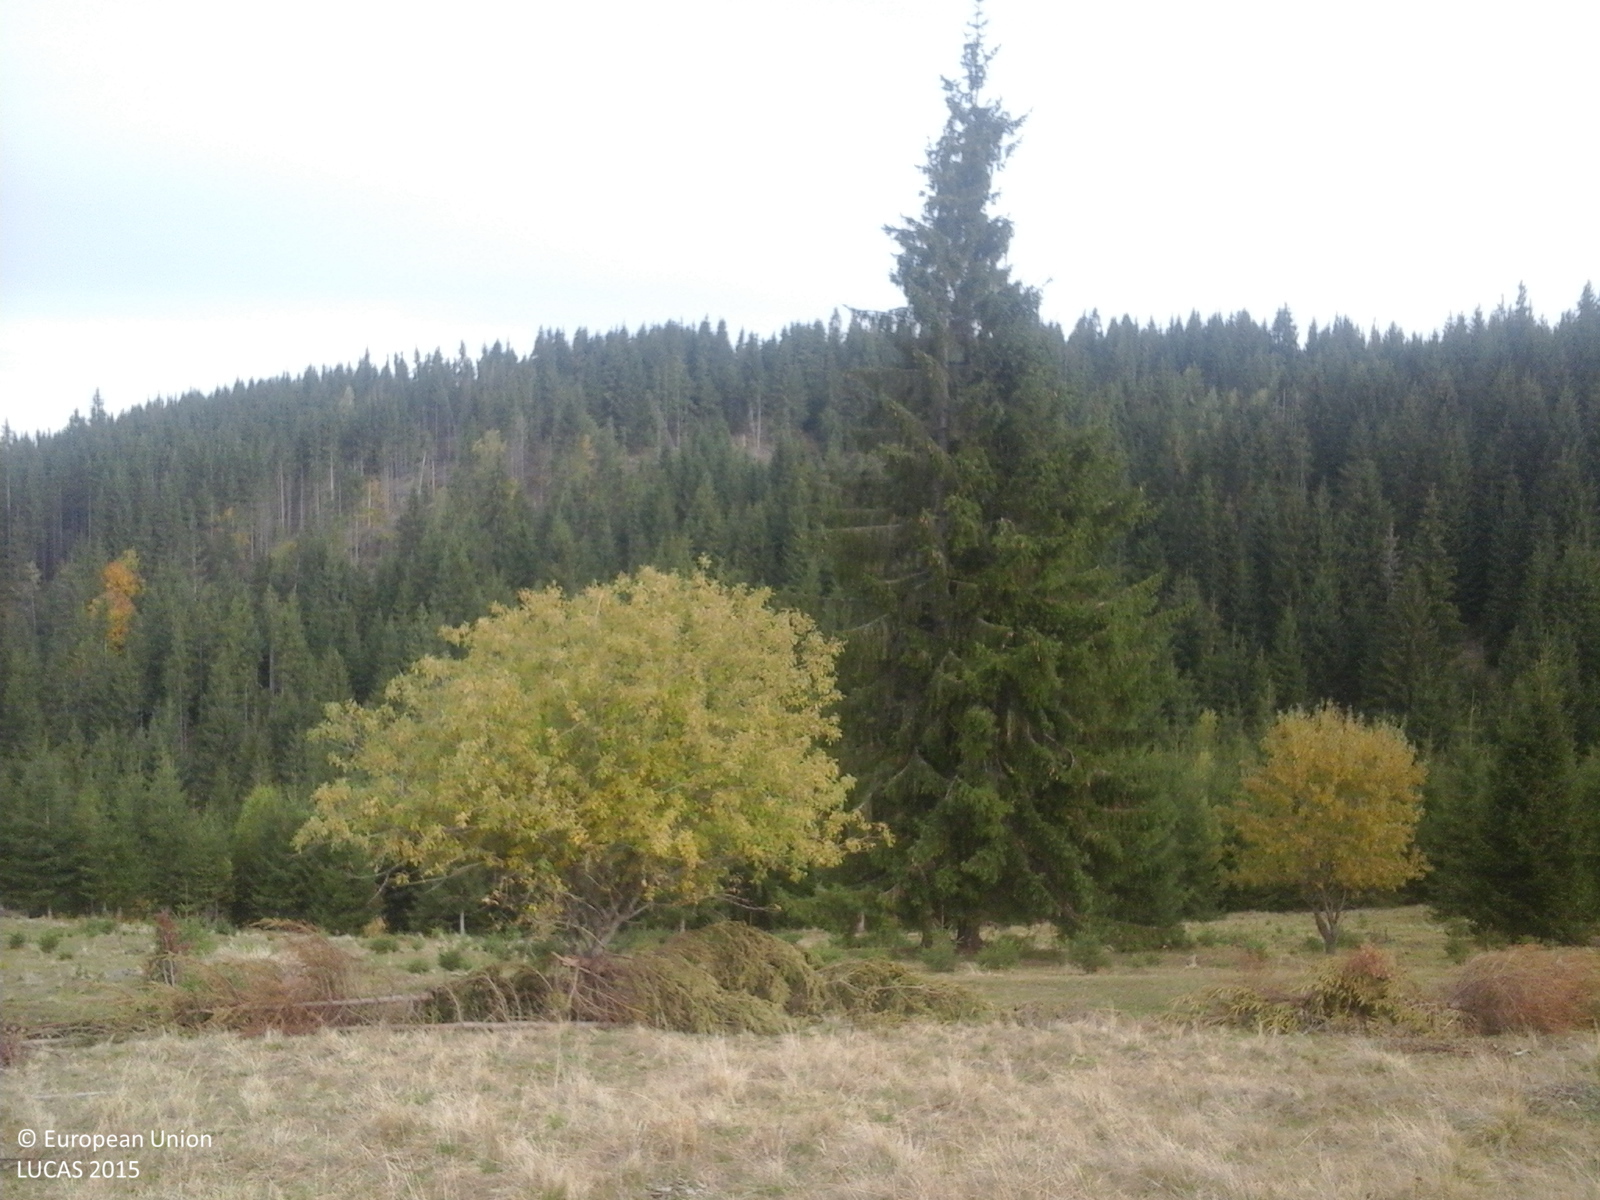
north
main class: Grassland
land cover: Grassland without tree/shrub cover
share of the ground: > 75 %
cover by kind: herbaceous plants 100 %
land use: Agriculture (excluding fallow land and kitchen gardens)
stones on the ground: < 10 %
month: October
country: RO
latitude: 46.5697
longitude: 25.8659
